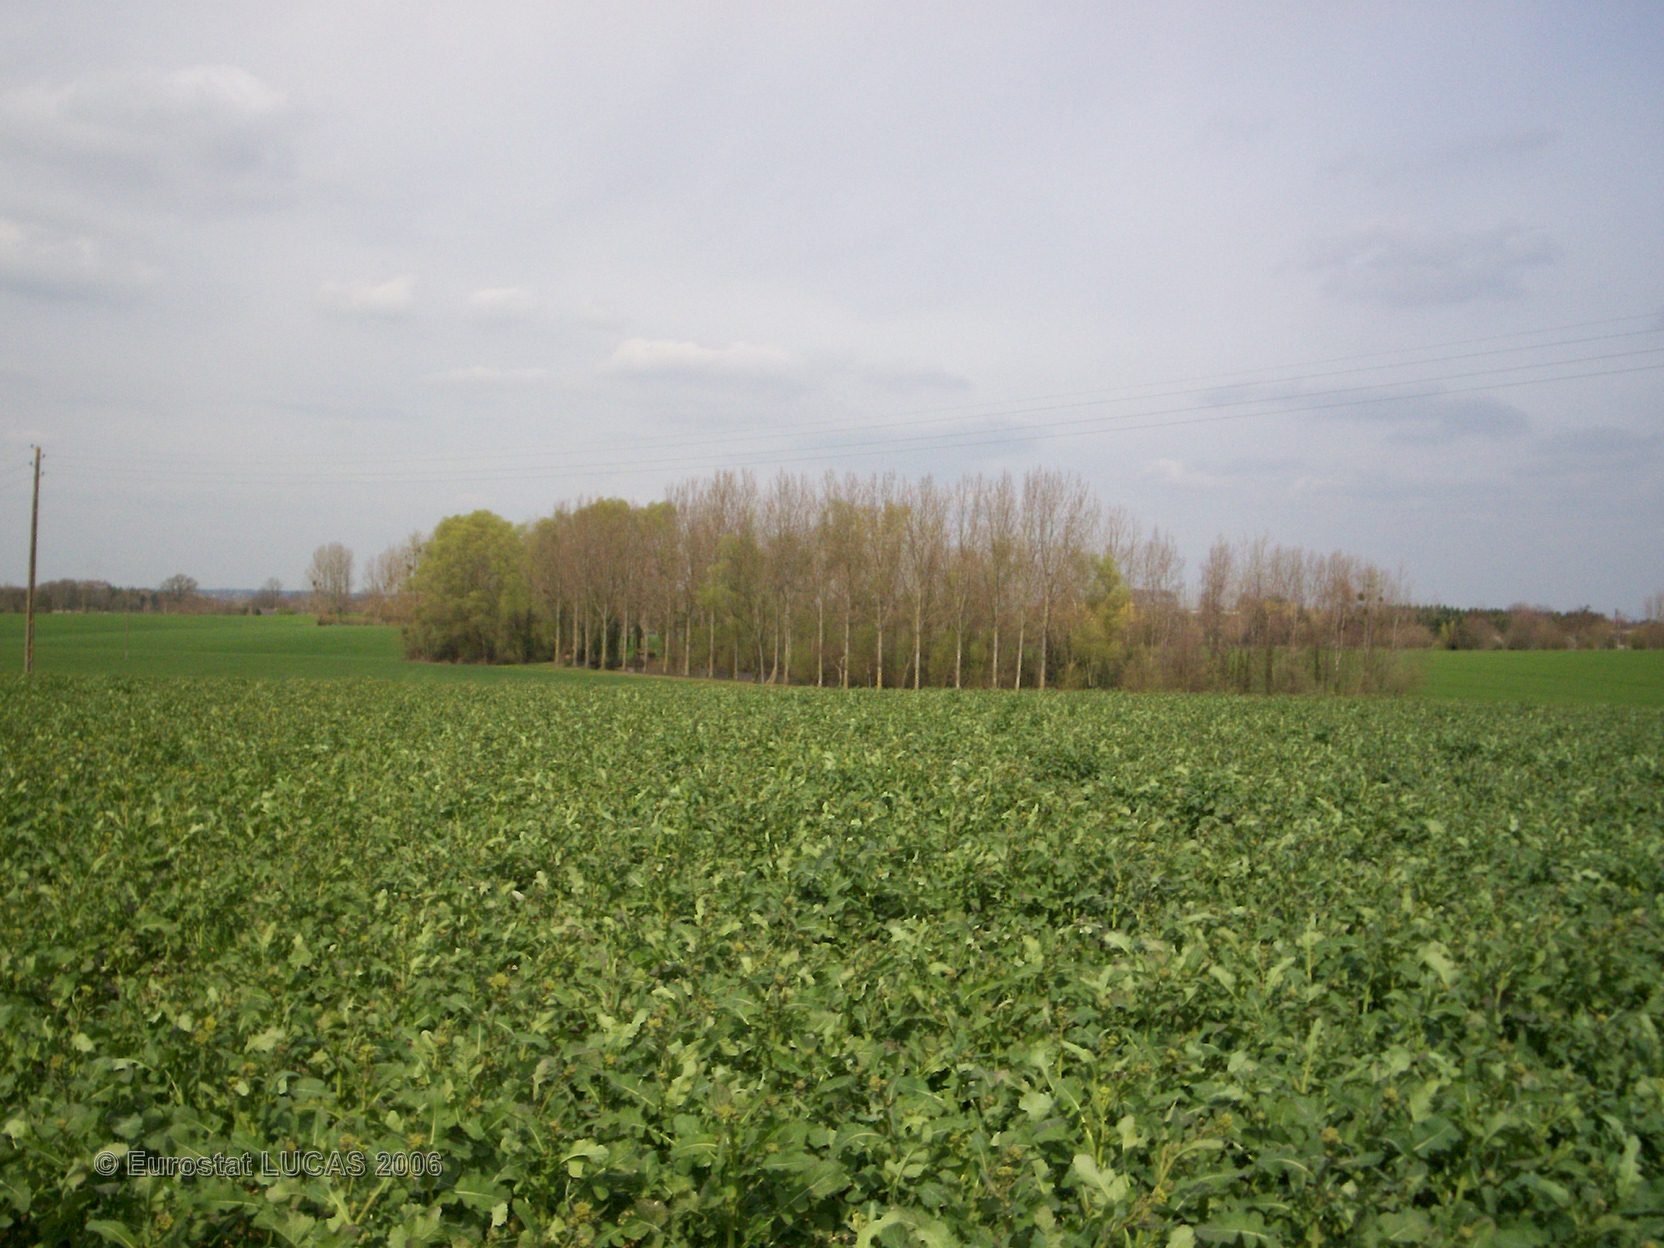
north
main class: Cropland
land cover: Rape and turnip rape
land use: Agriculture (excluding fallow land and kitchen gardens)
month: April
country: FR
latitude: 47.9923
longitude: -1.5841
